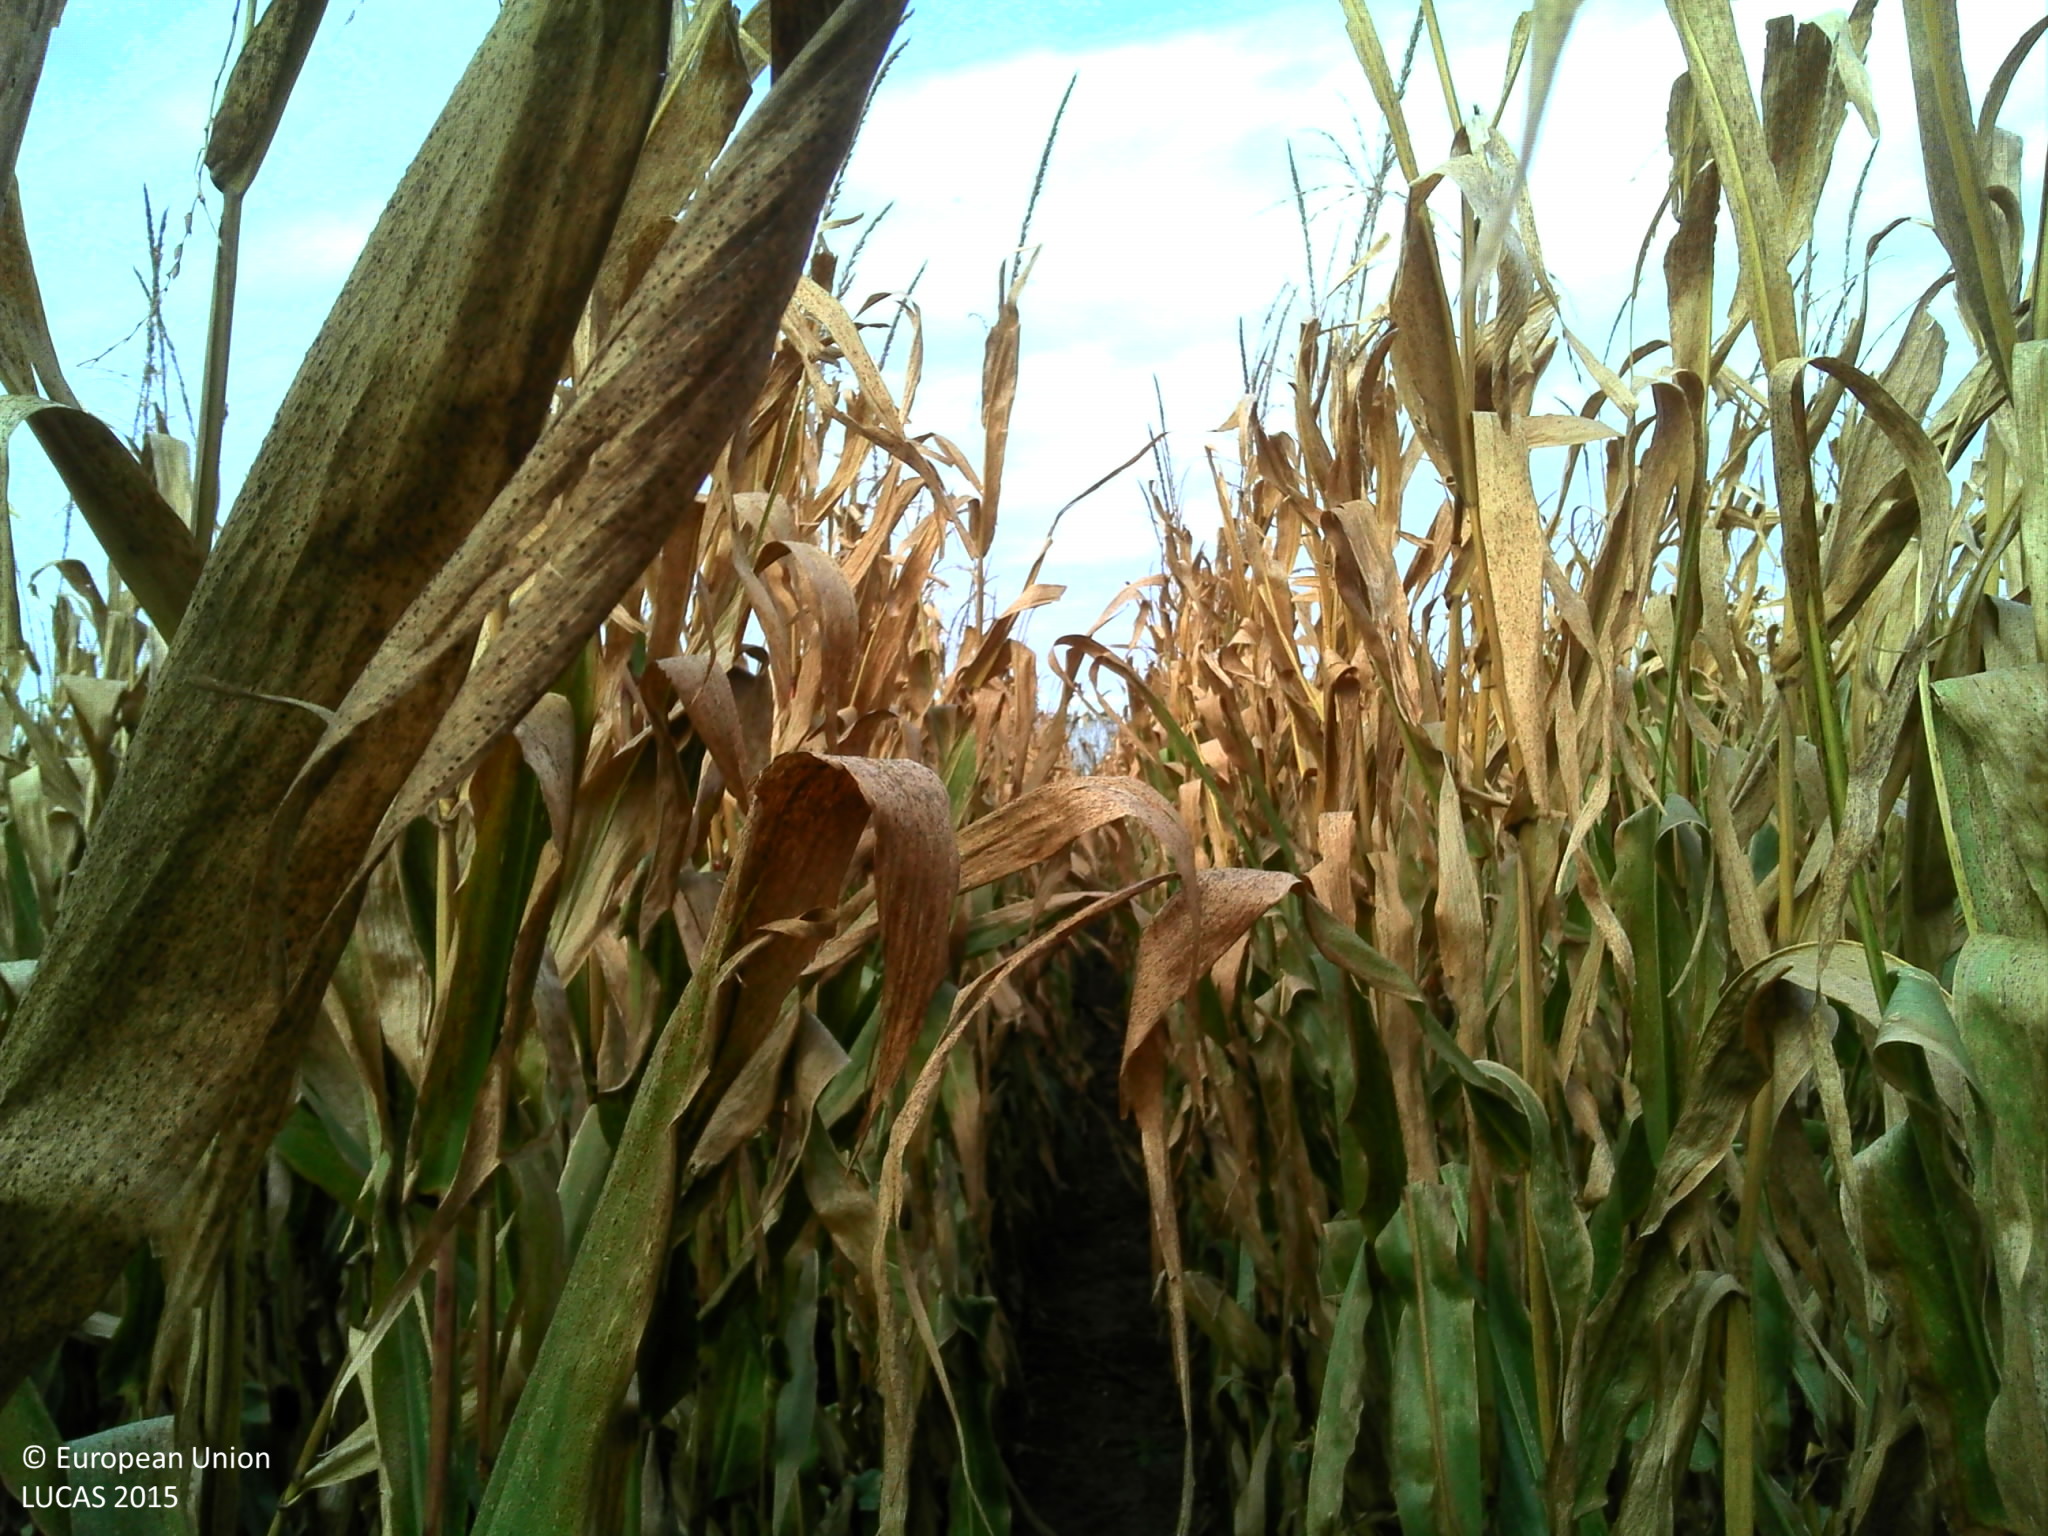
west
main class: Cropland
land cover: Maize
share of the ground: > 75 %
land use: Agriculture (excluding fallow land and kitchen gardens)
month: October
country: FR
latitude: 46.4634
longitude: -1.0880
